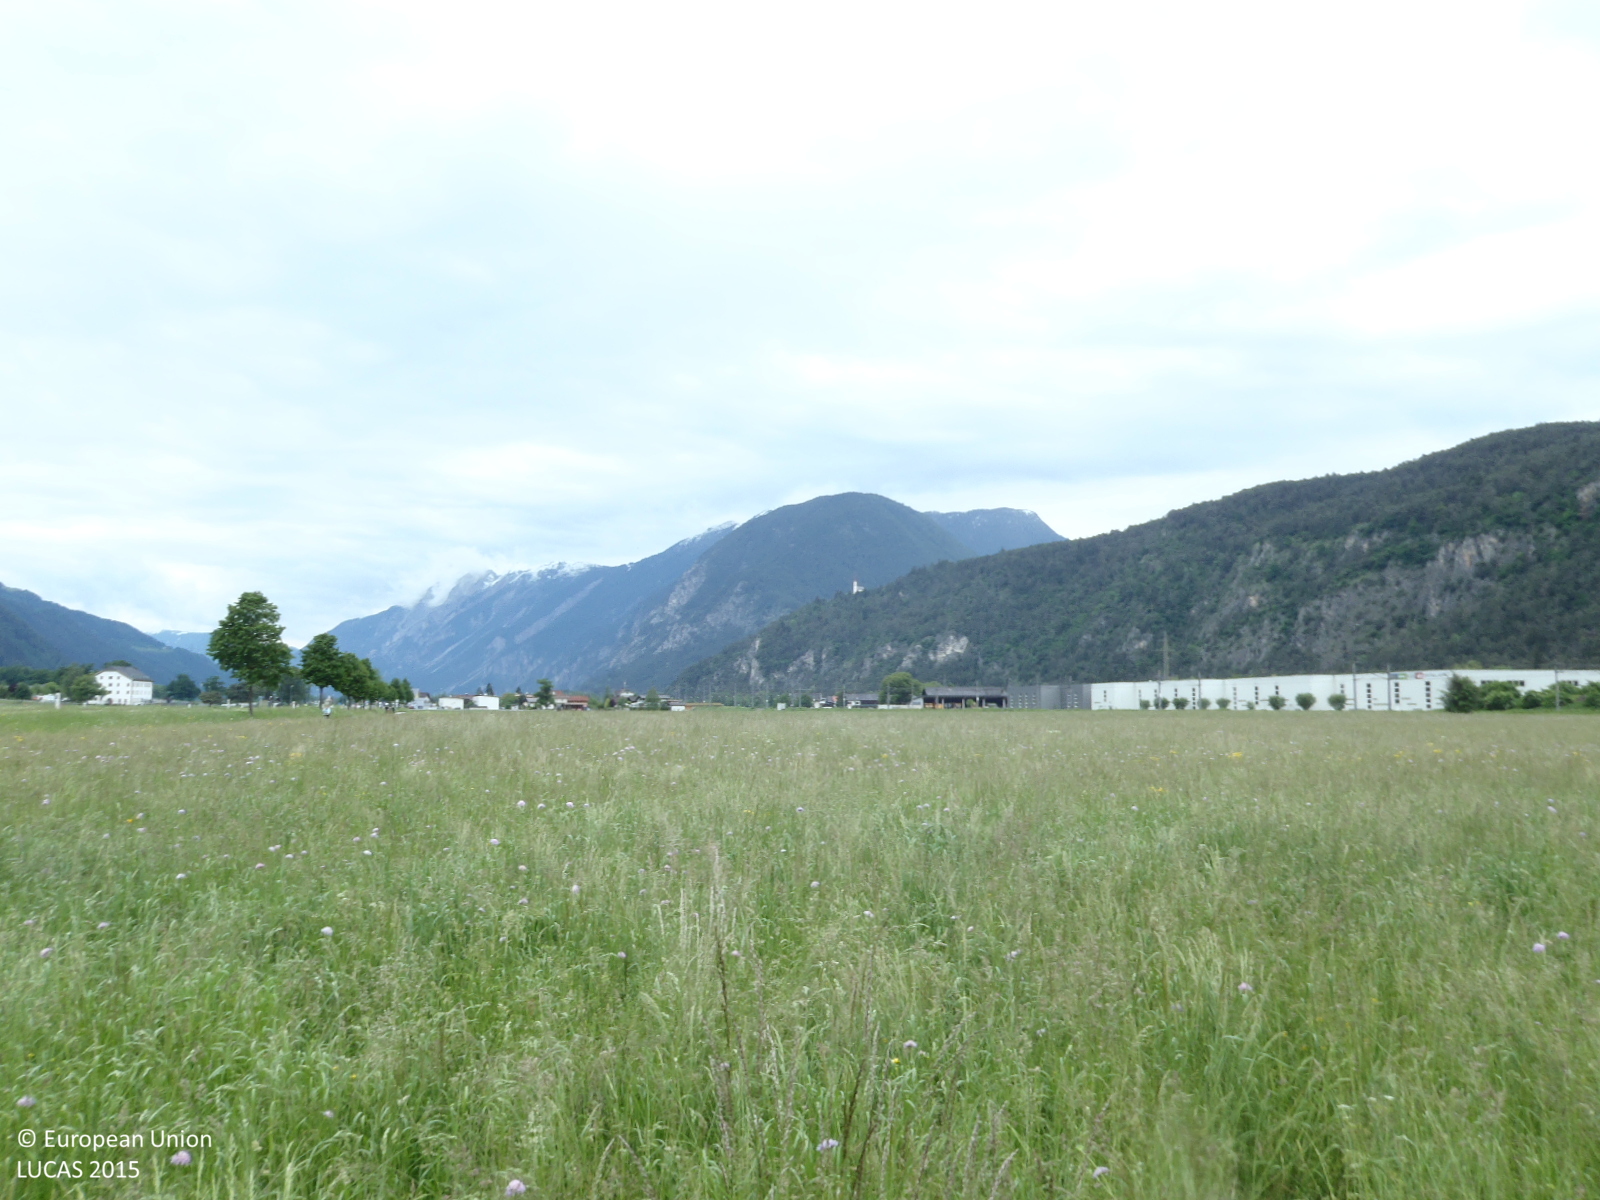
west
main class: Cropland
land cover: Maize
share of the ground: < 10 %
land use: Agriculture (excluding fallow land and kitchen gardens)
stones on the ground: < 10 %
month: May
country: AT
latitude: 47.2831
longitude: 10.9907
